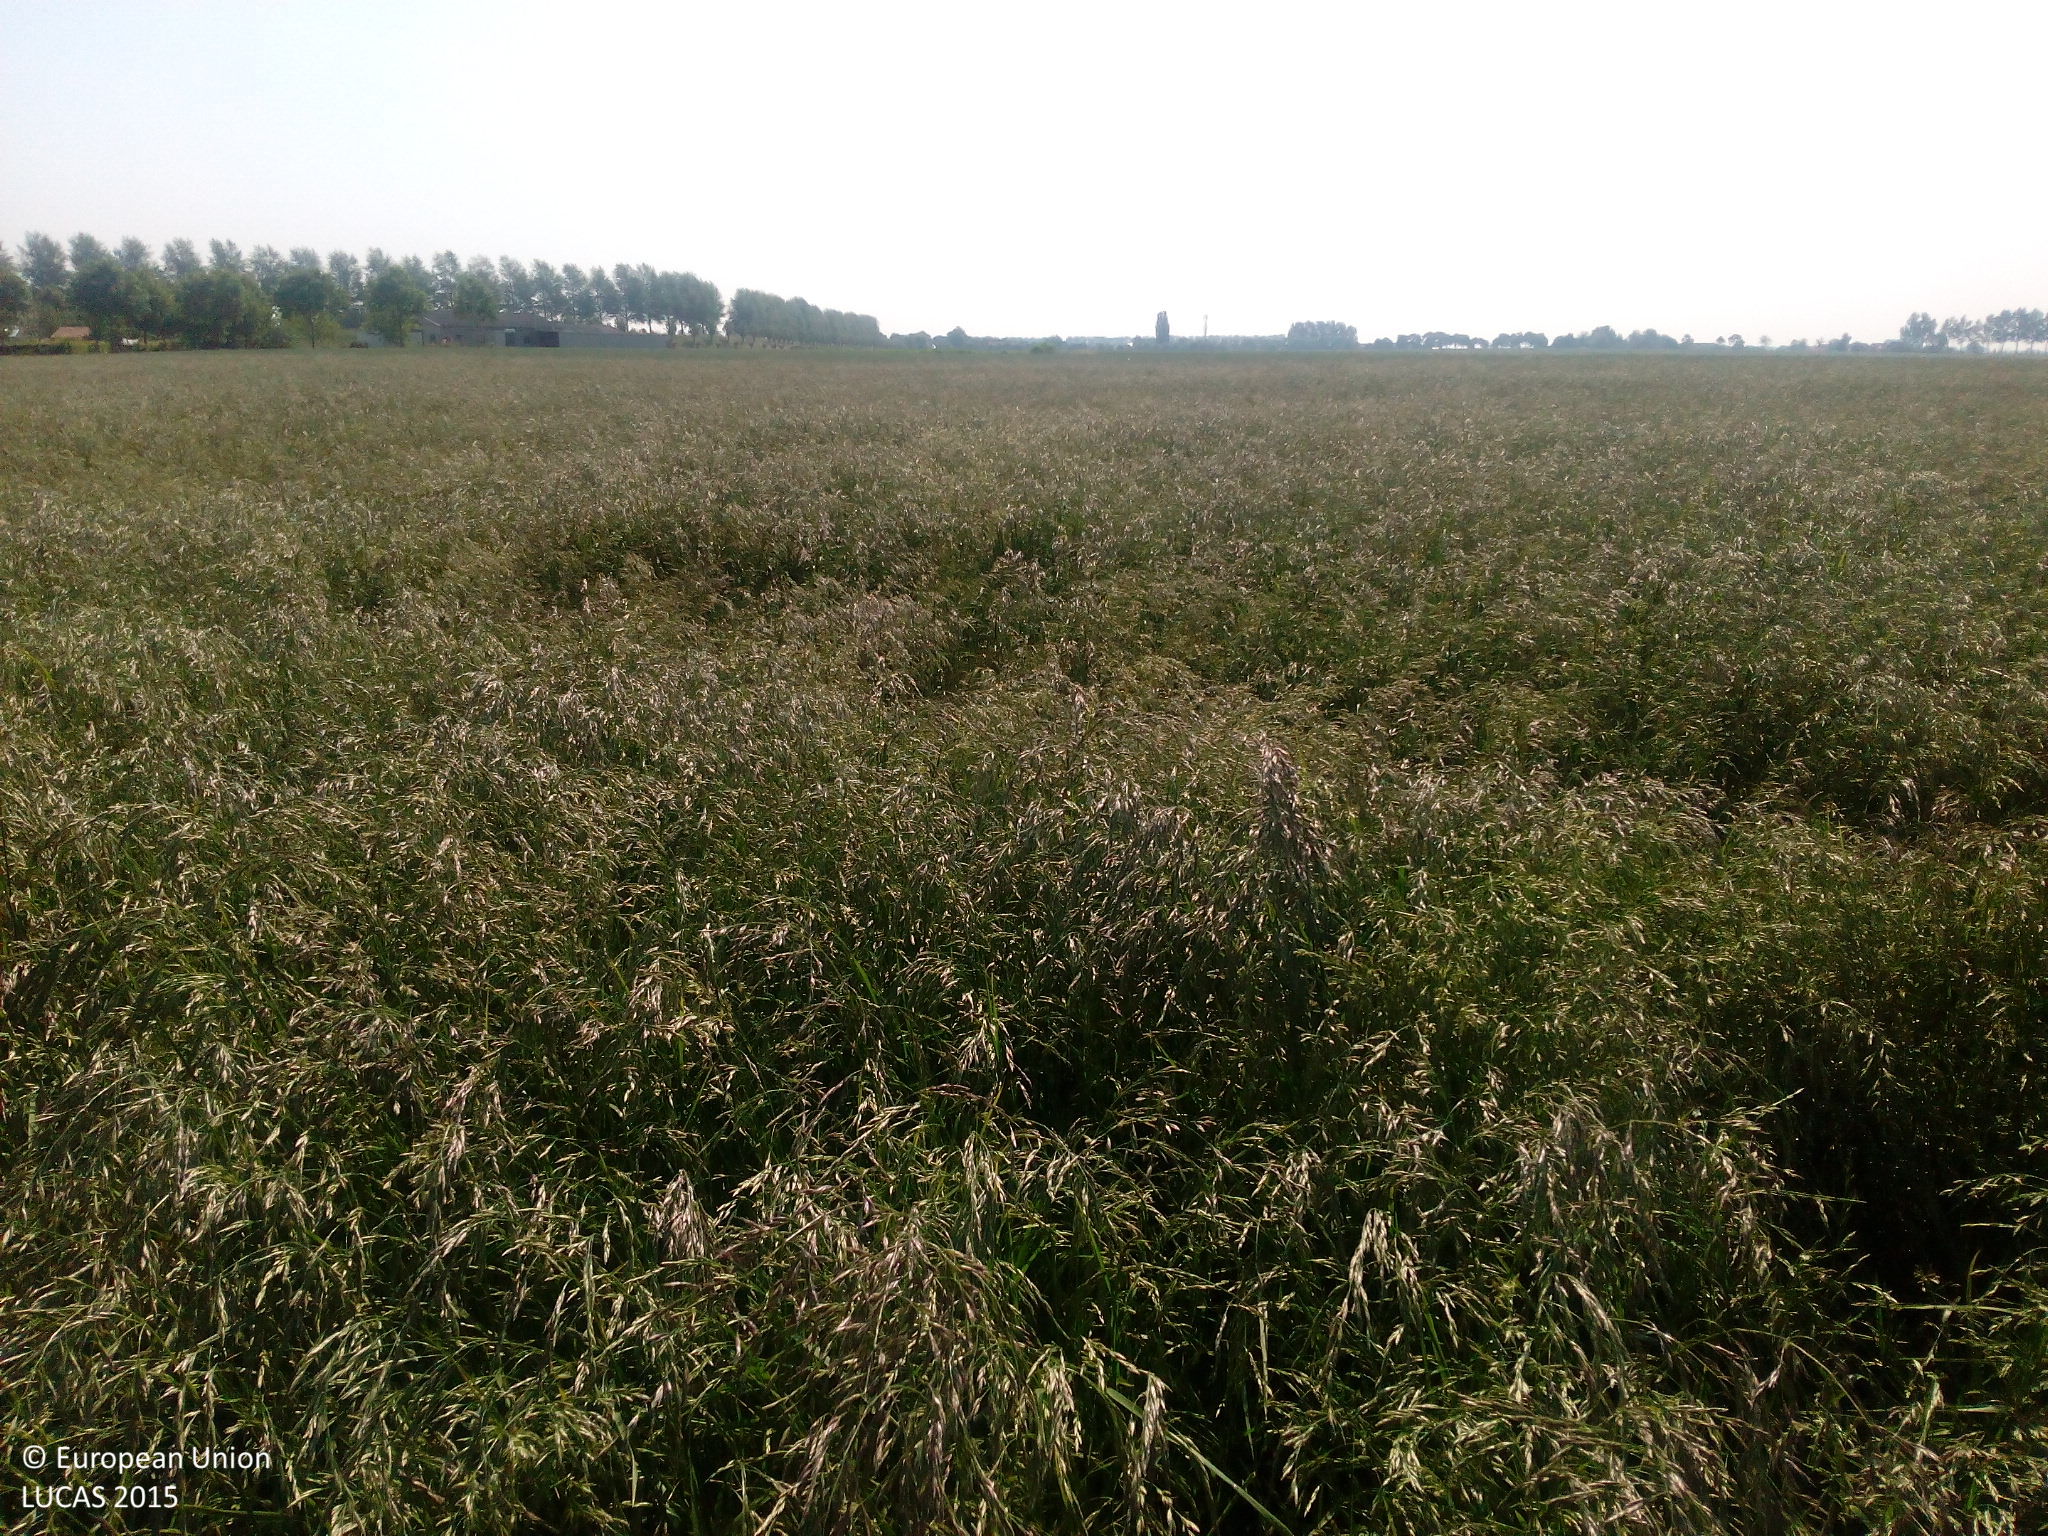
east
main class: Cropland
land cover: Temporary grasslands
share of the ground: > 75 %
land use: Agriculture (excluding fallow land and kitchen gardens)
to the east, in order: Temporary grasslands; Common wheat; Ditches and canals; Grass margins; Paved roads, cycling and walking lanes; Grass margins; Ditches and canals; Grass margins; Other fibre and oleaginous crops
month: June
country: NL
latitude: 51.5679
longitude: 4.1807
